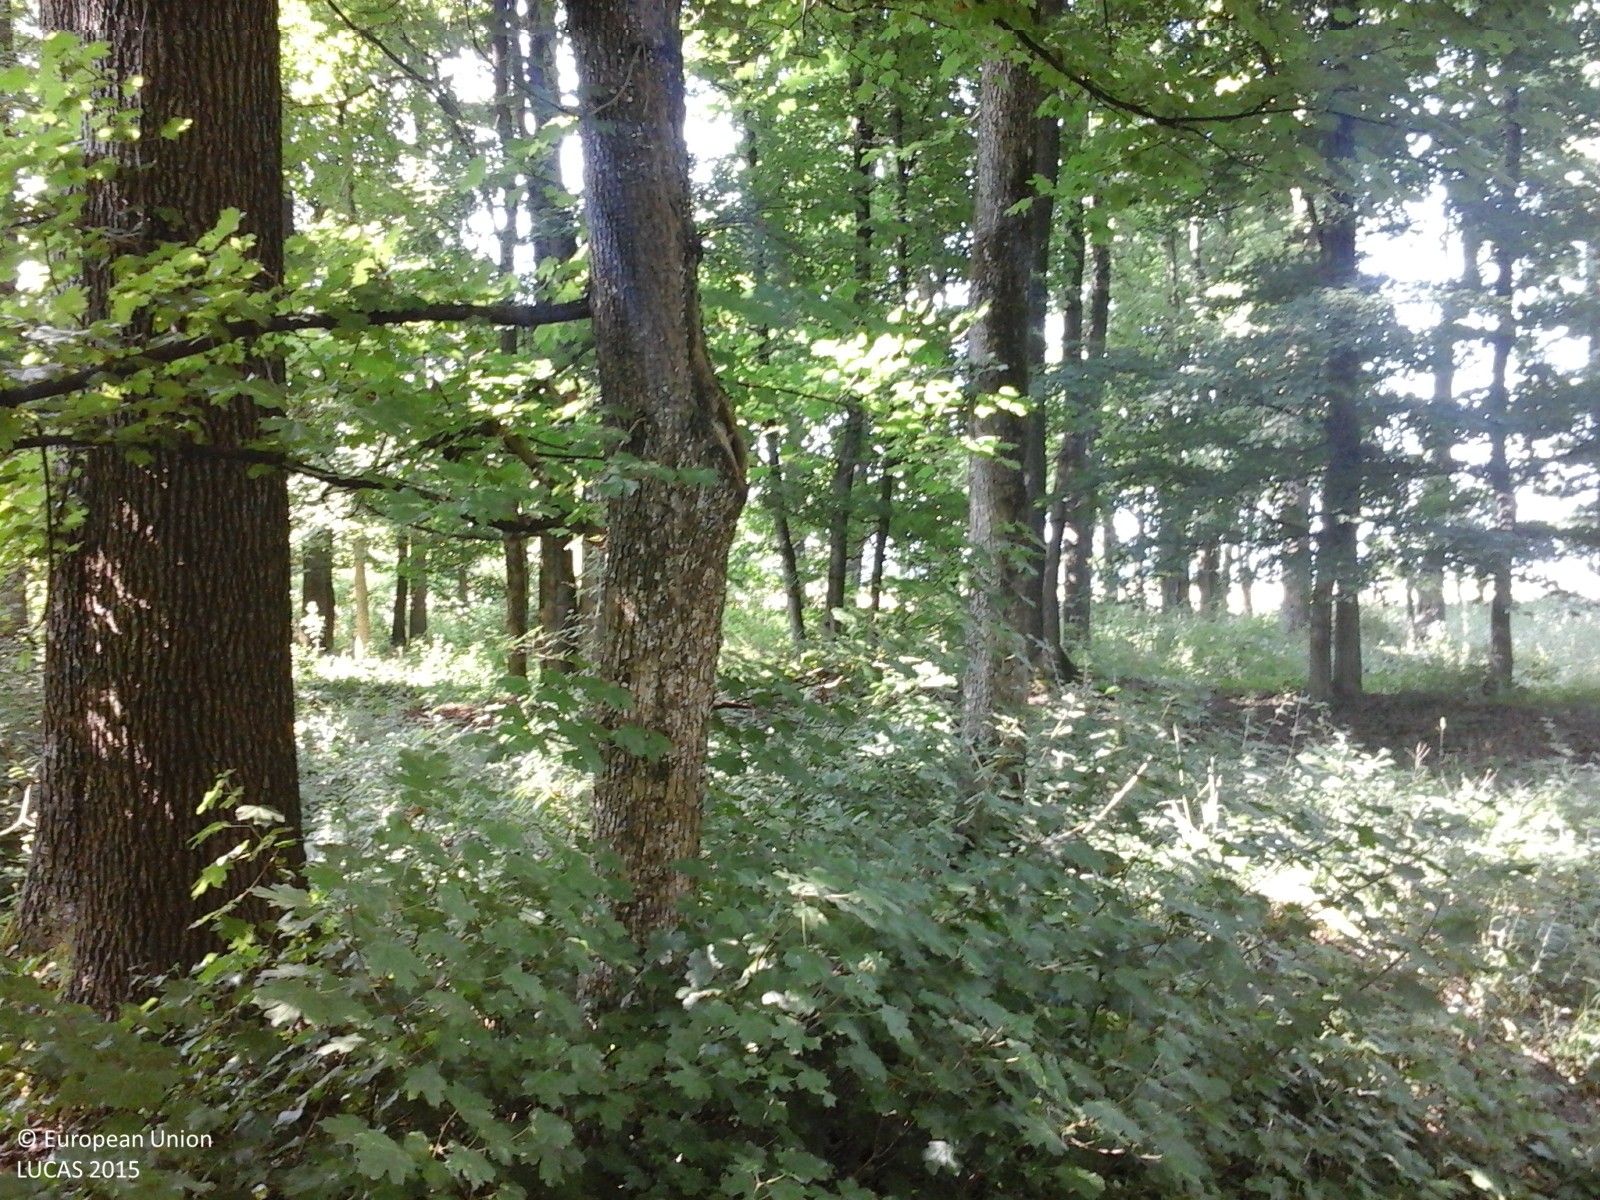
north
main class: Woodland
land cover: Broadleaved woodland
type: mesophytic deciduous forest
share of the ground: > 75 %
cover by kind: broadleaved forest trees 85 %, herbaceous plants 10 %, shrubs 5 %
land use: Forestry
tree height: > 5 m
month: June
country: RO
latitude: 44.5300
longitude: 26.1254
